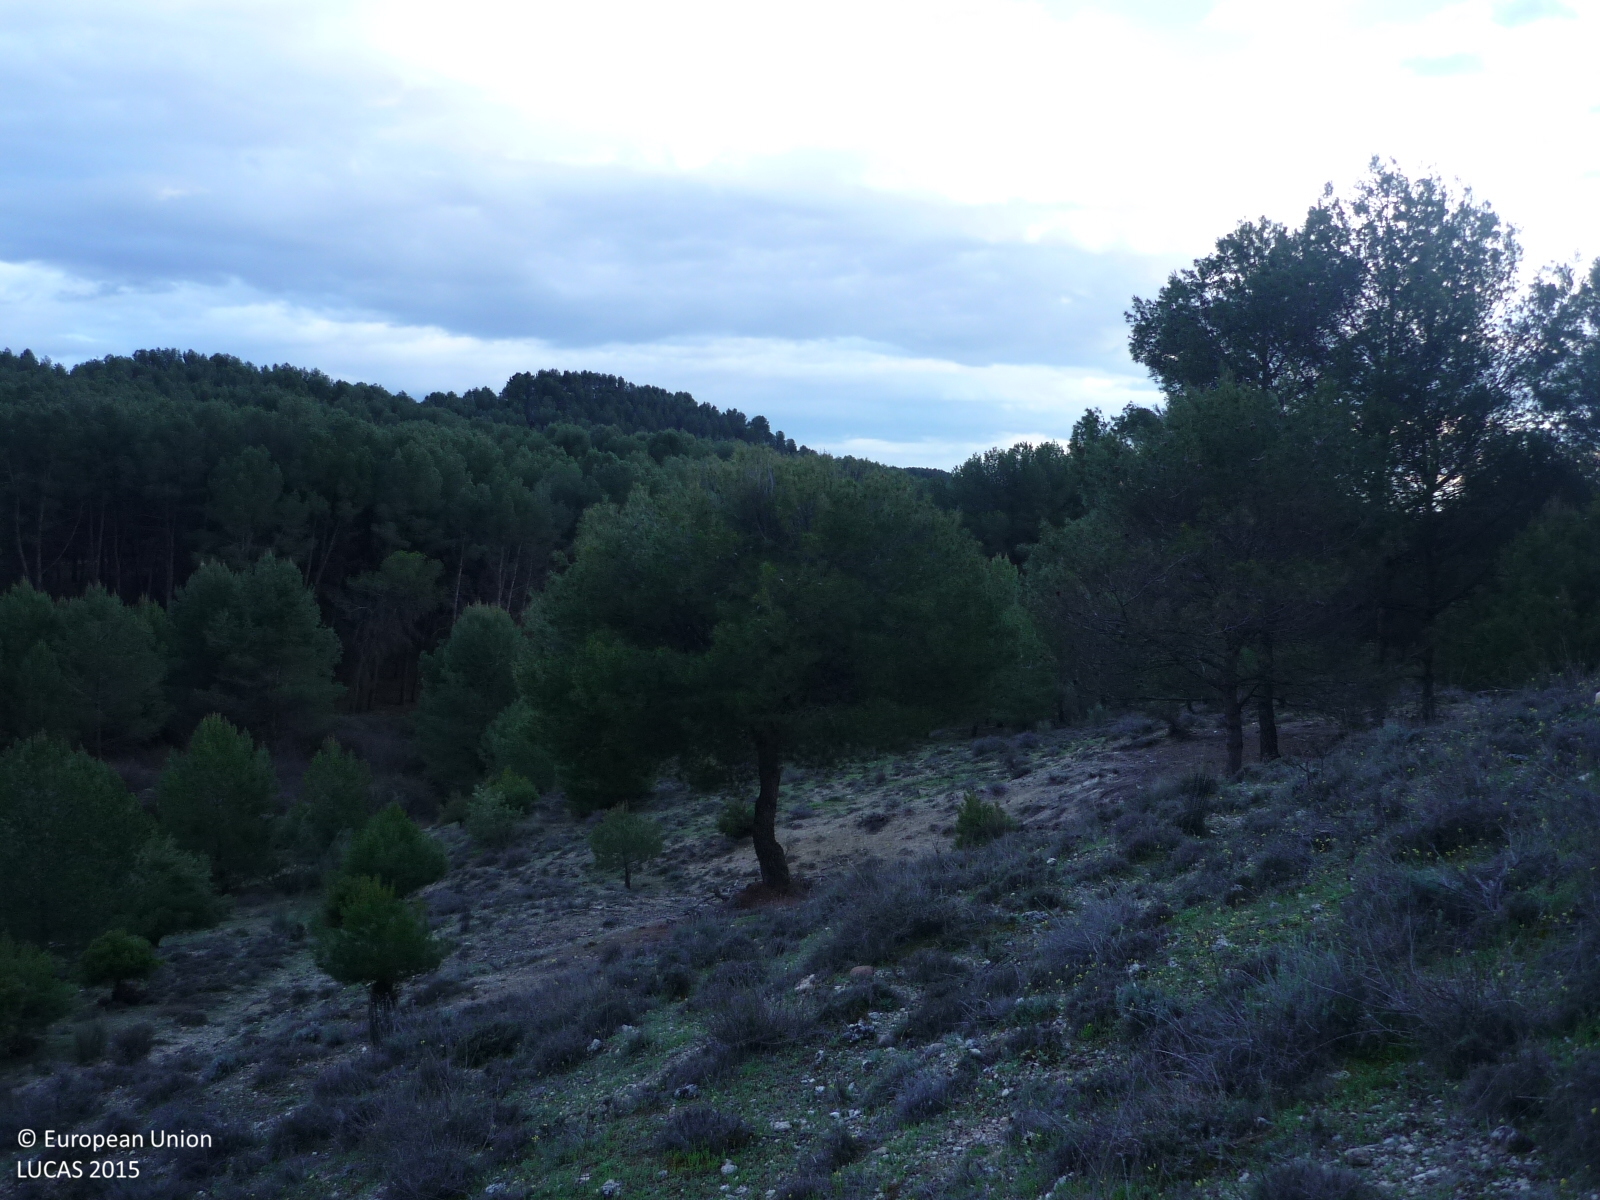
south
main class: Woodland
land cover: Pine dominated coniferous woodland
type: coniferous forest of the mediterranean region
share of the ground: 10 - 25 %
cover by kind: herbaceous plants 45 %, coniferous forest trees 20 %, consolidated bare surface 20 %, shrubs 15 %
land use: Semi-natural and natural areas not in use
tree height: < 5 m
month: March
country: ES
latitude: 40.4805
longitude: -3.5192
